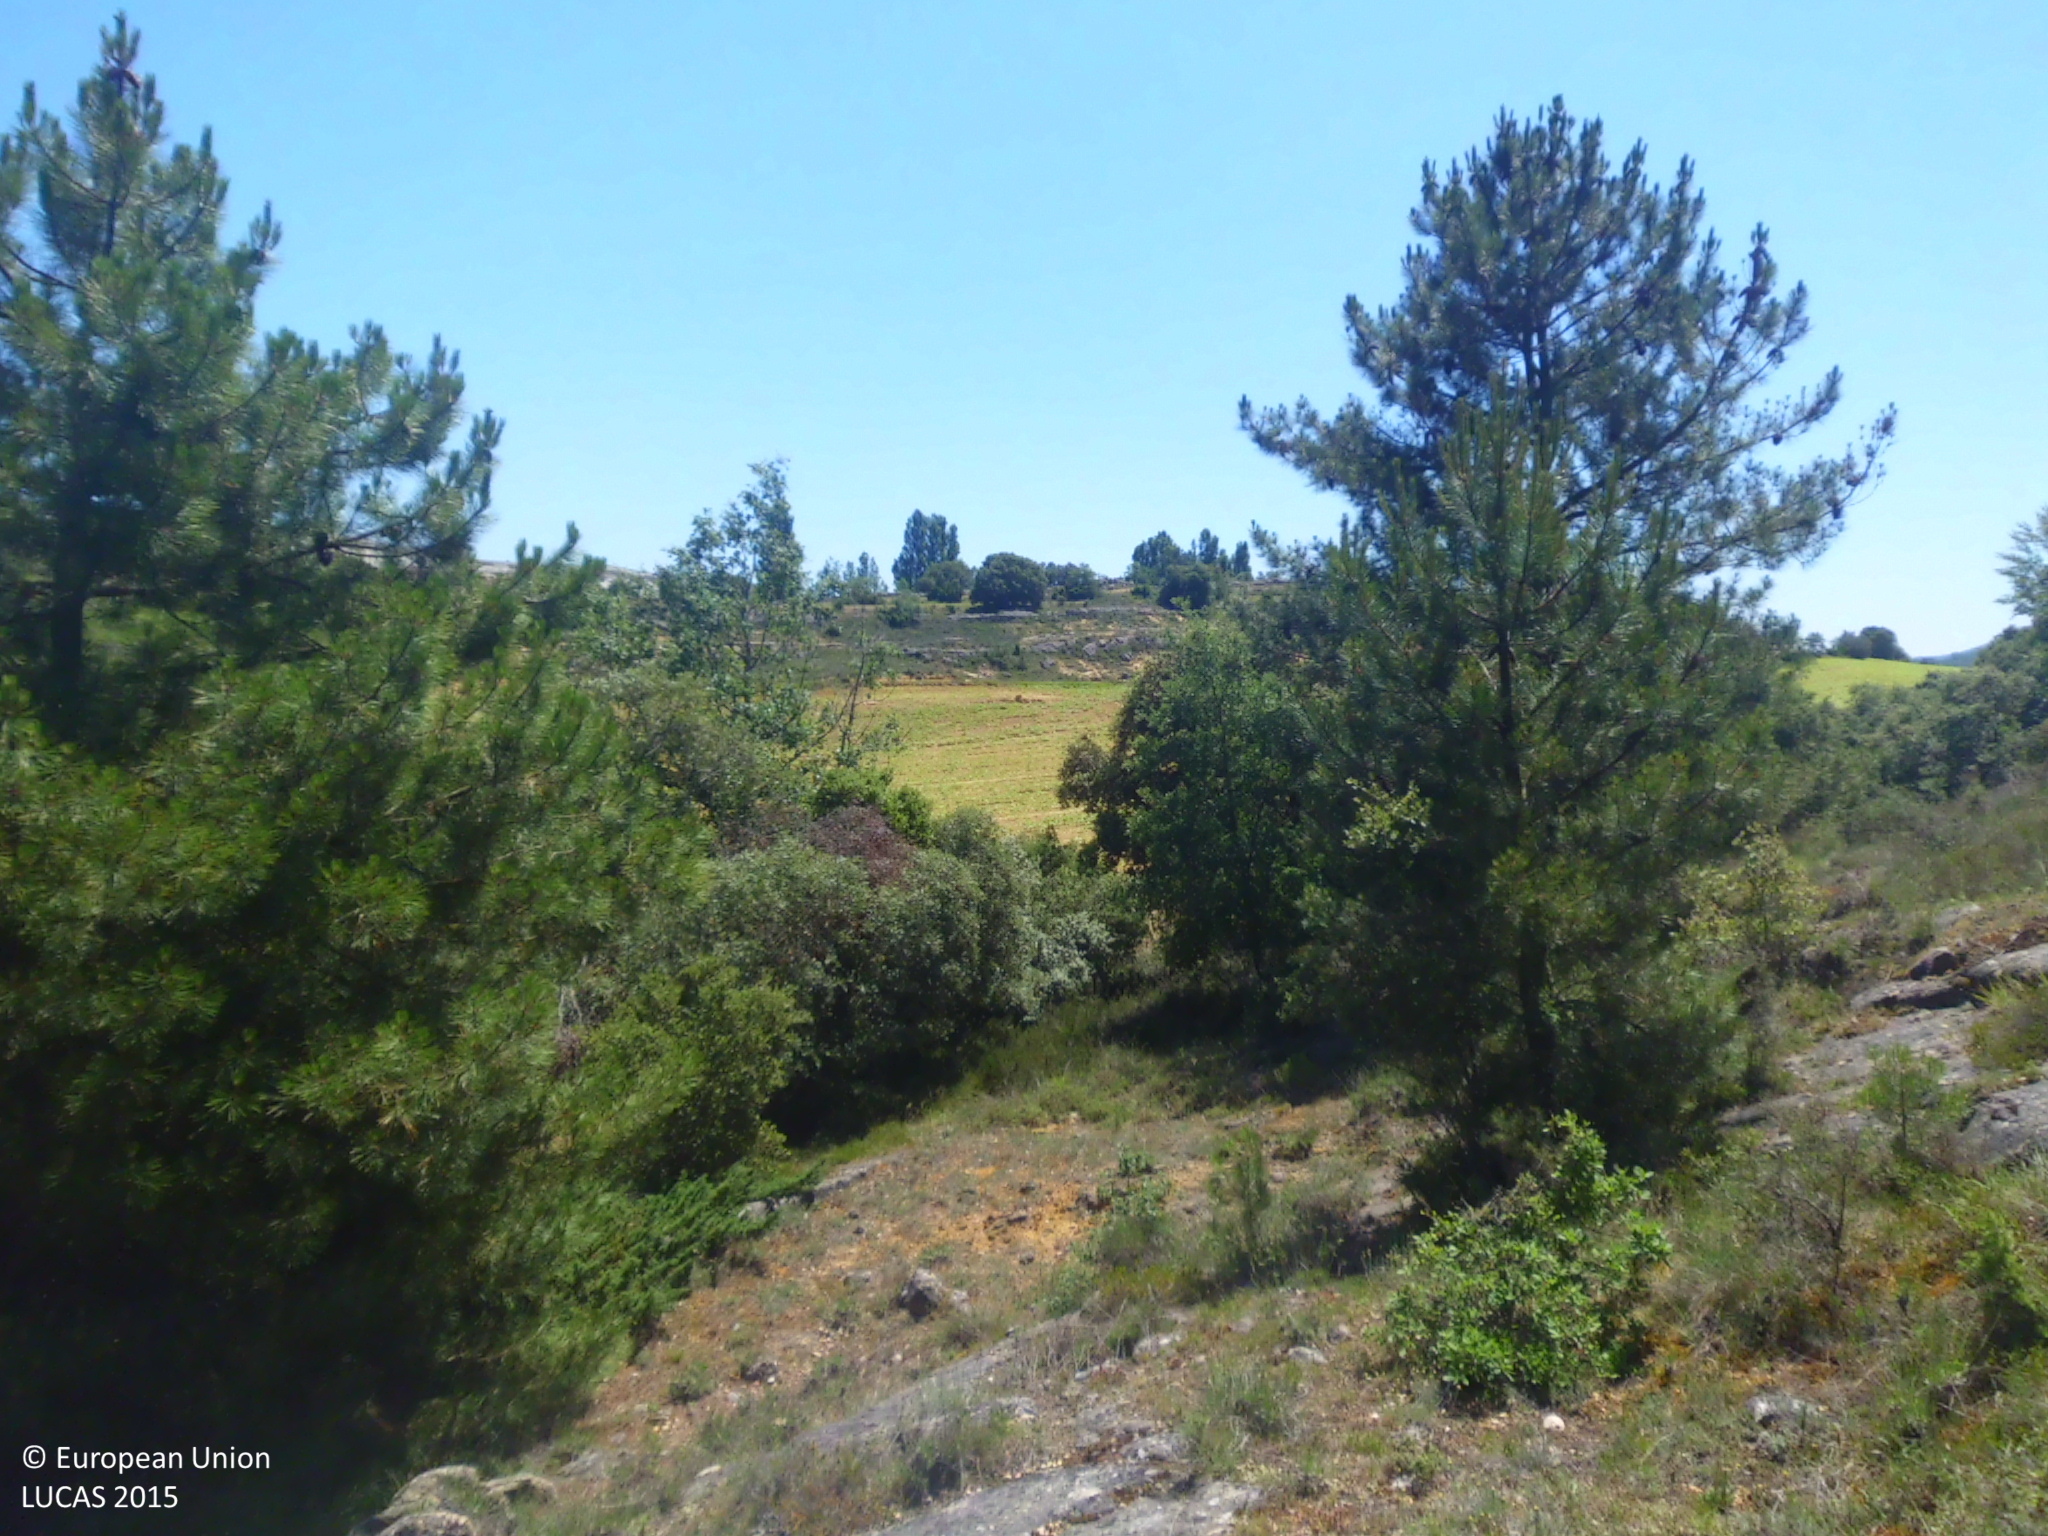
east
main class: Shrubland
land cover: Shrubland with sparse tree cover
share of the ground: 25 - 50 %
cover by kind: herbaceous plants 50 %, shrubs 35 %, consolidated bare surface 10 %, coniferous forest trees 5 %
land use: Semi-natural and natural areas not in use
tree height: < 5 m
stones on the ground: 10 - 25 %
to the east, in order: Shrubland with sparse tree cover; Rock outcrops; Other mixed woodland; Sunflower; Grassland with sparse tree/shrub cover; Common wheat; Rock outcrops; Grassland with sparse tree/shrub cover; Rock outcrops; Grassland with sparse tree/shrub cover; Common wheat
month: June
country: ES
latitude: 42.8944
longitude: -3.5218
